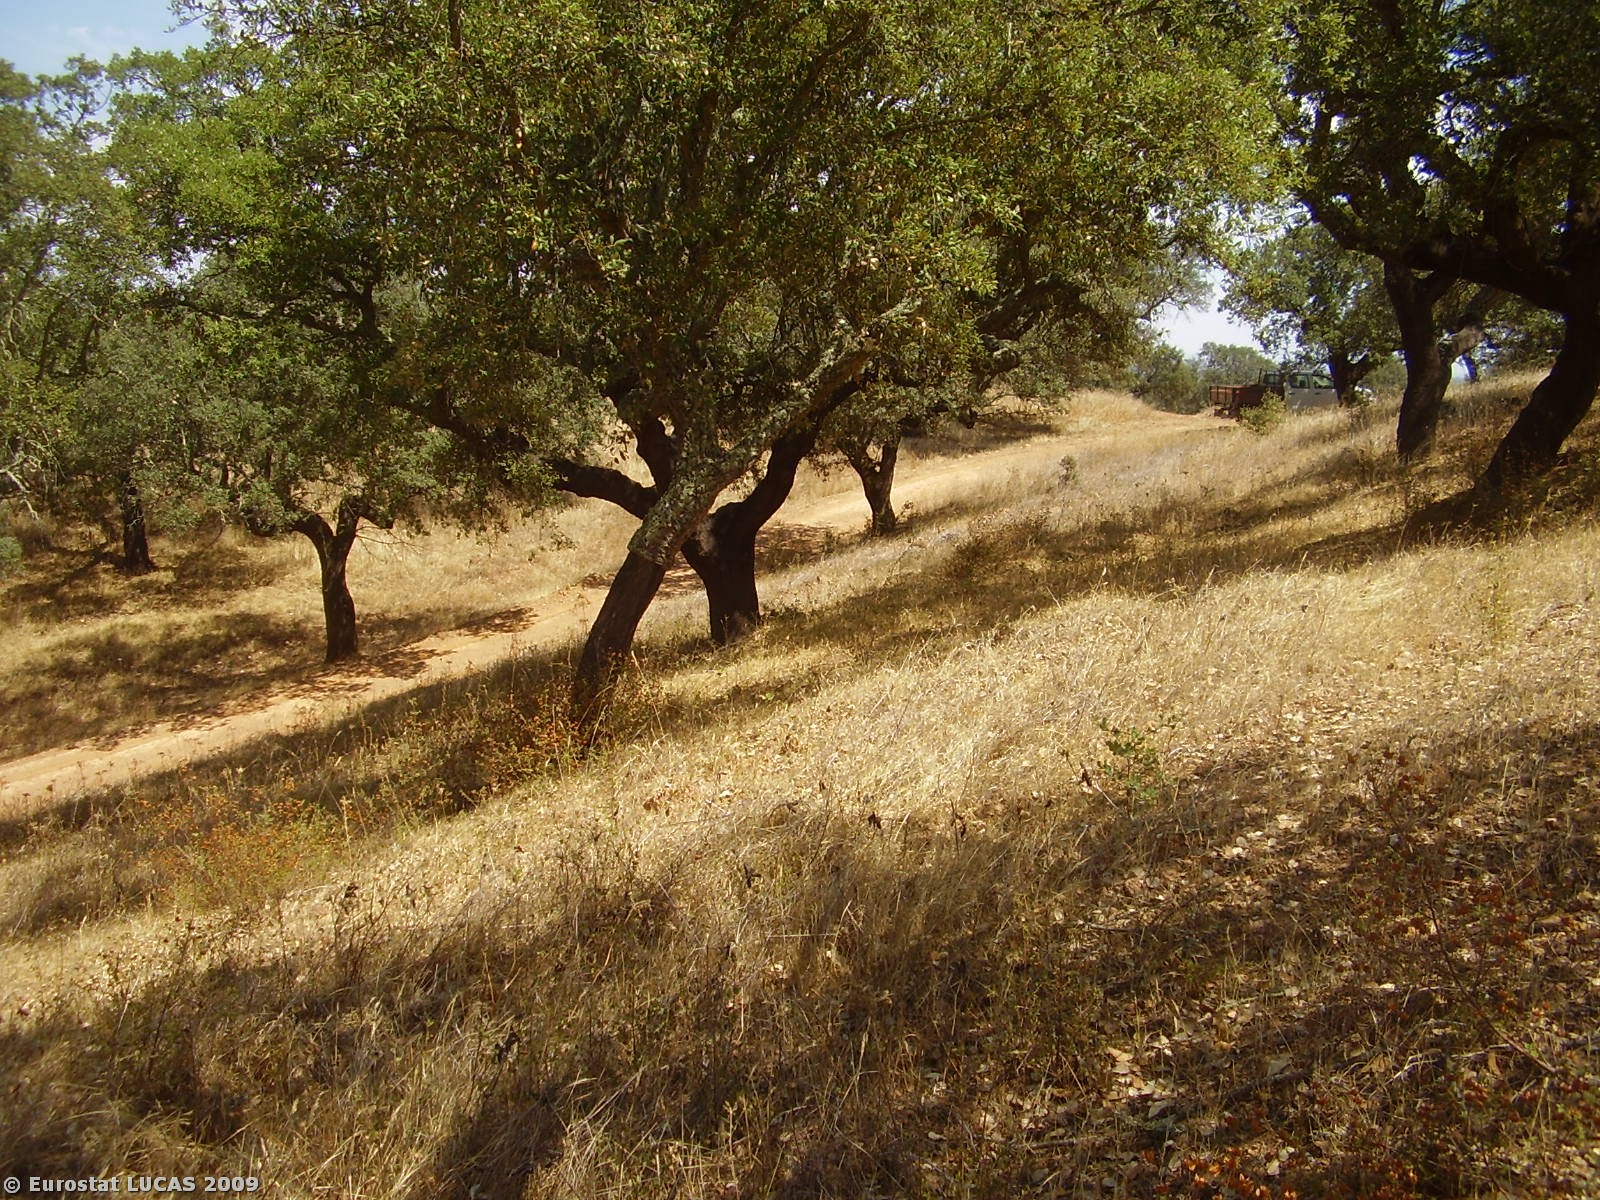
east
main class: Woodland
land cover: Broadleaved woodland
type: broadleaved evergreen forest
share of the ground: 25 - 50 %
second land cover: Spontaneously vegetated surfaces
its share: > 75 %
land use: Forestry
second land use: Fallow land
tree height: > 5 m
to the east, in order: Broadleaved woodland; Spontaneously vegetated surfaces; Broadleaved woodland; Tracks; Broadleaved woodland; Fences; Broadleaved woodland; Grassland without tree/shrub cover
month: August
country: PT
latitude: 38.3101
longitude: -7.6051
